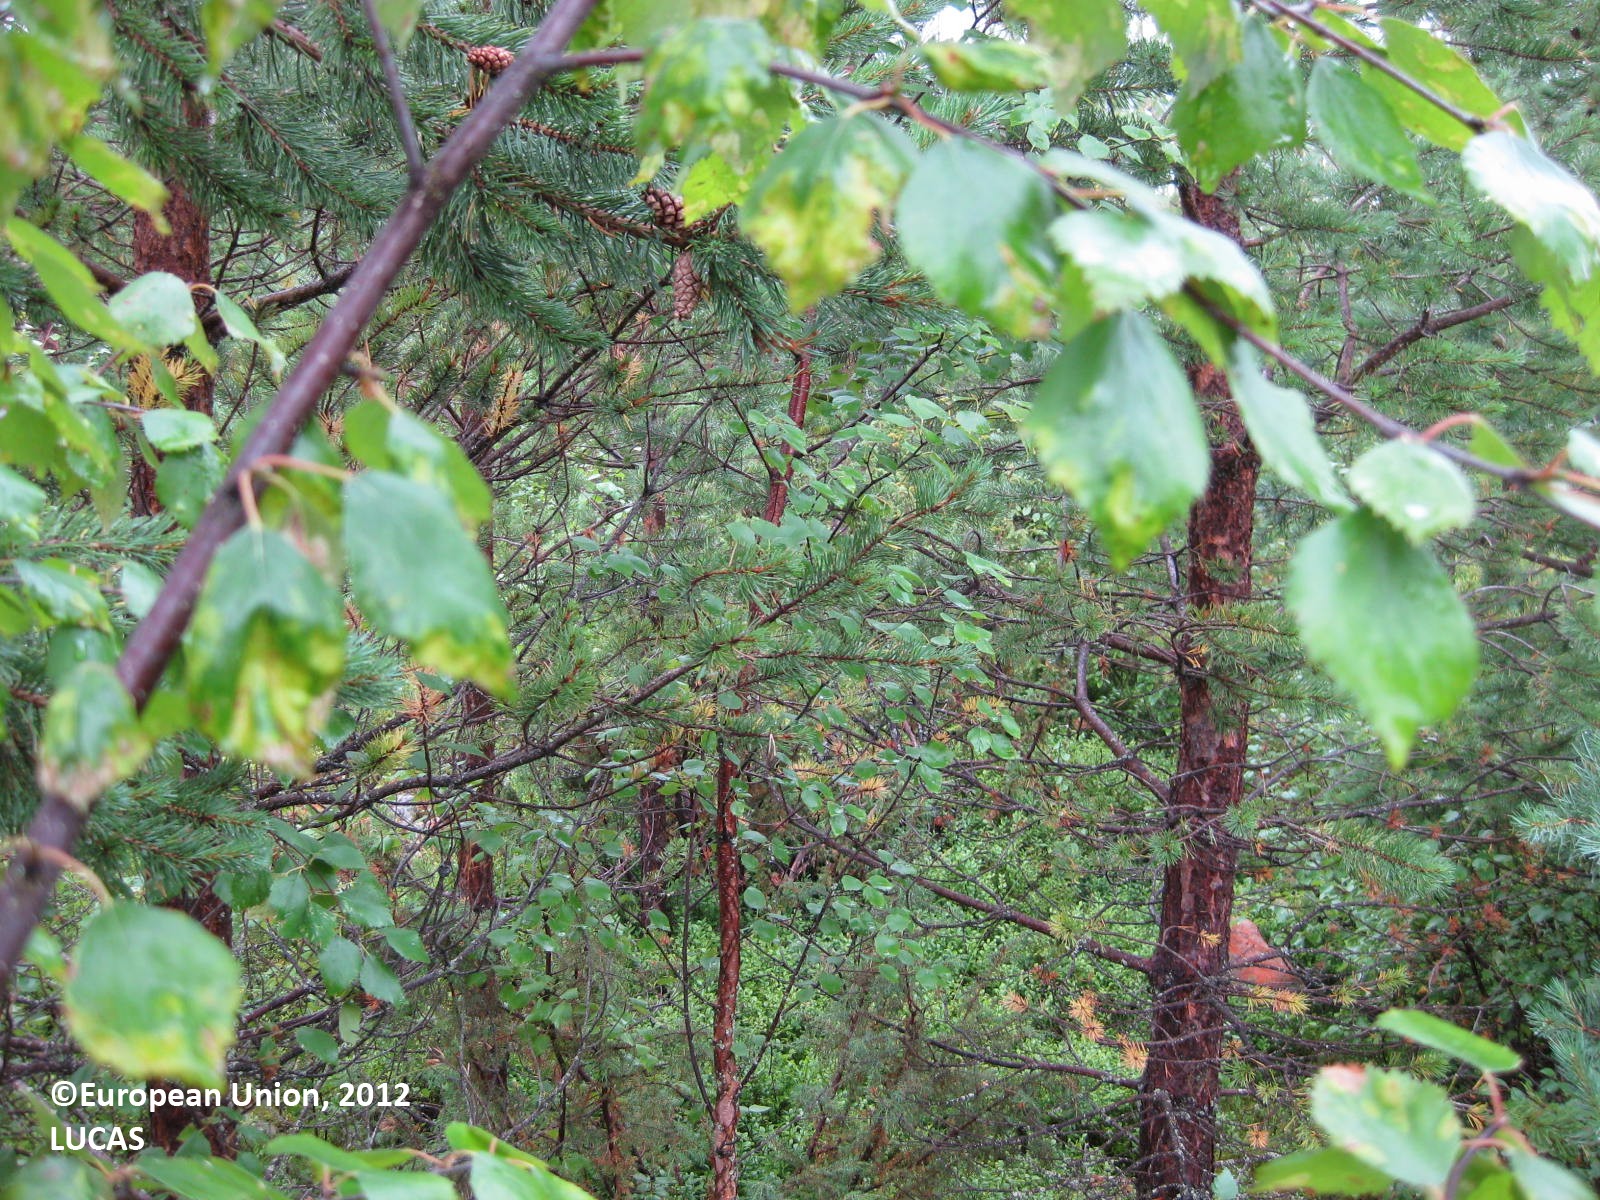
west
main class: Woodland
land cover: Pine dominated mixed woodland
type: boreal forest
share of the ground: > 75 %
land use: Forestry
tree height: > 5 m
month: August
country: FI
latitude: 66.0940
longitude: 28.2104
